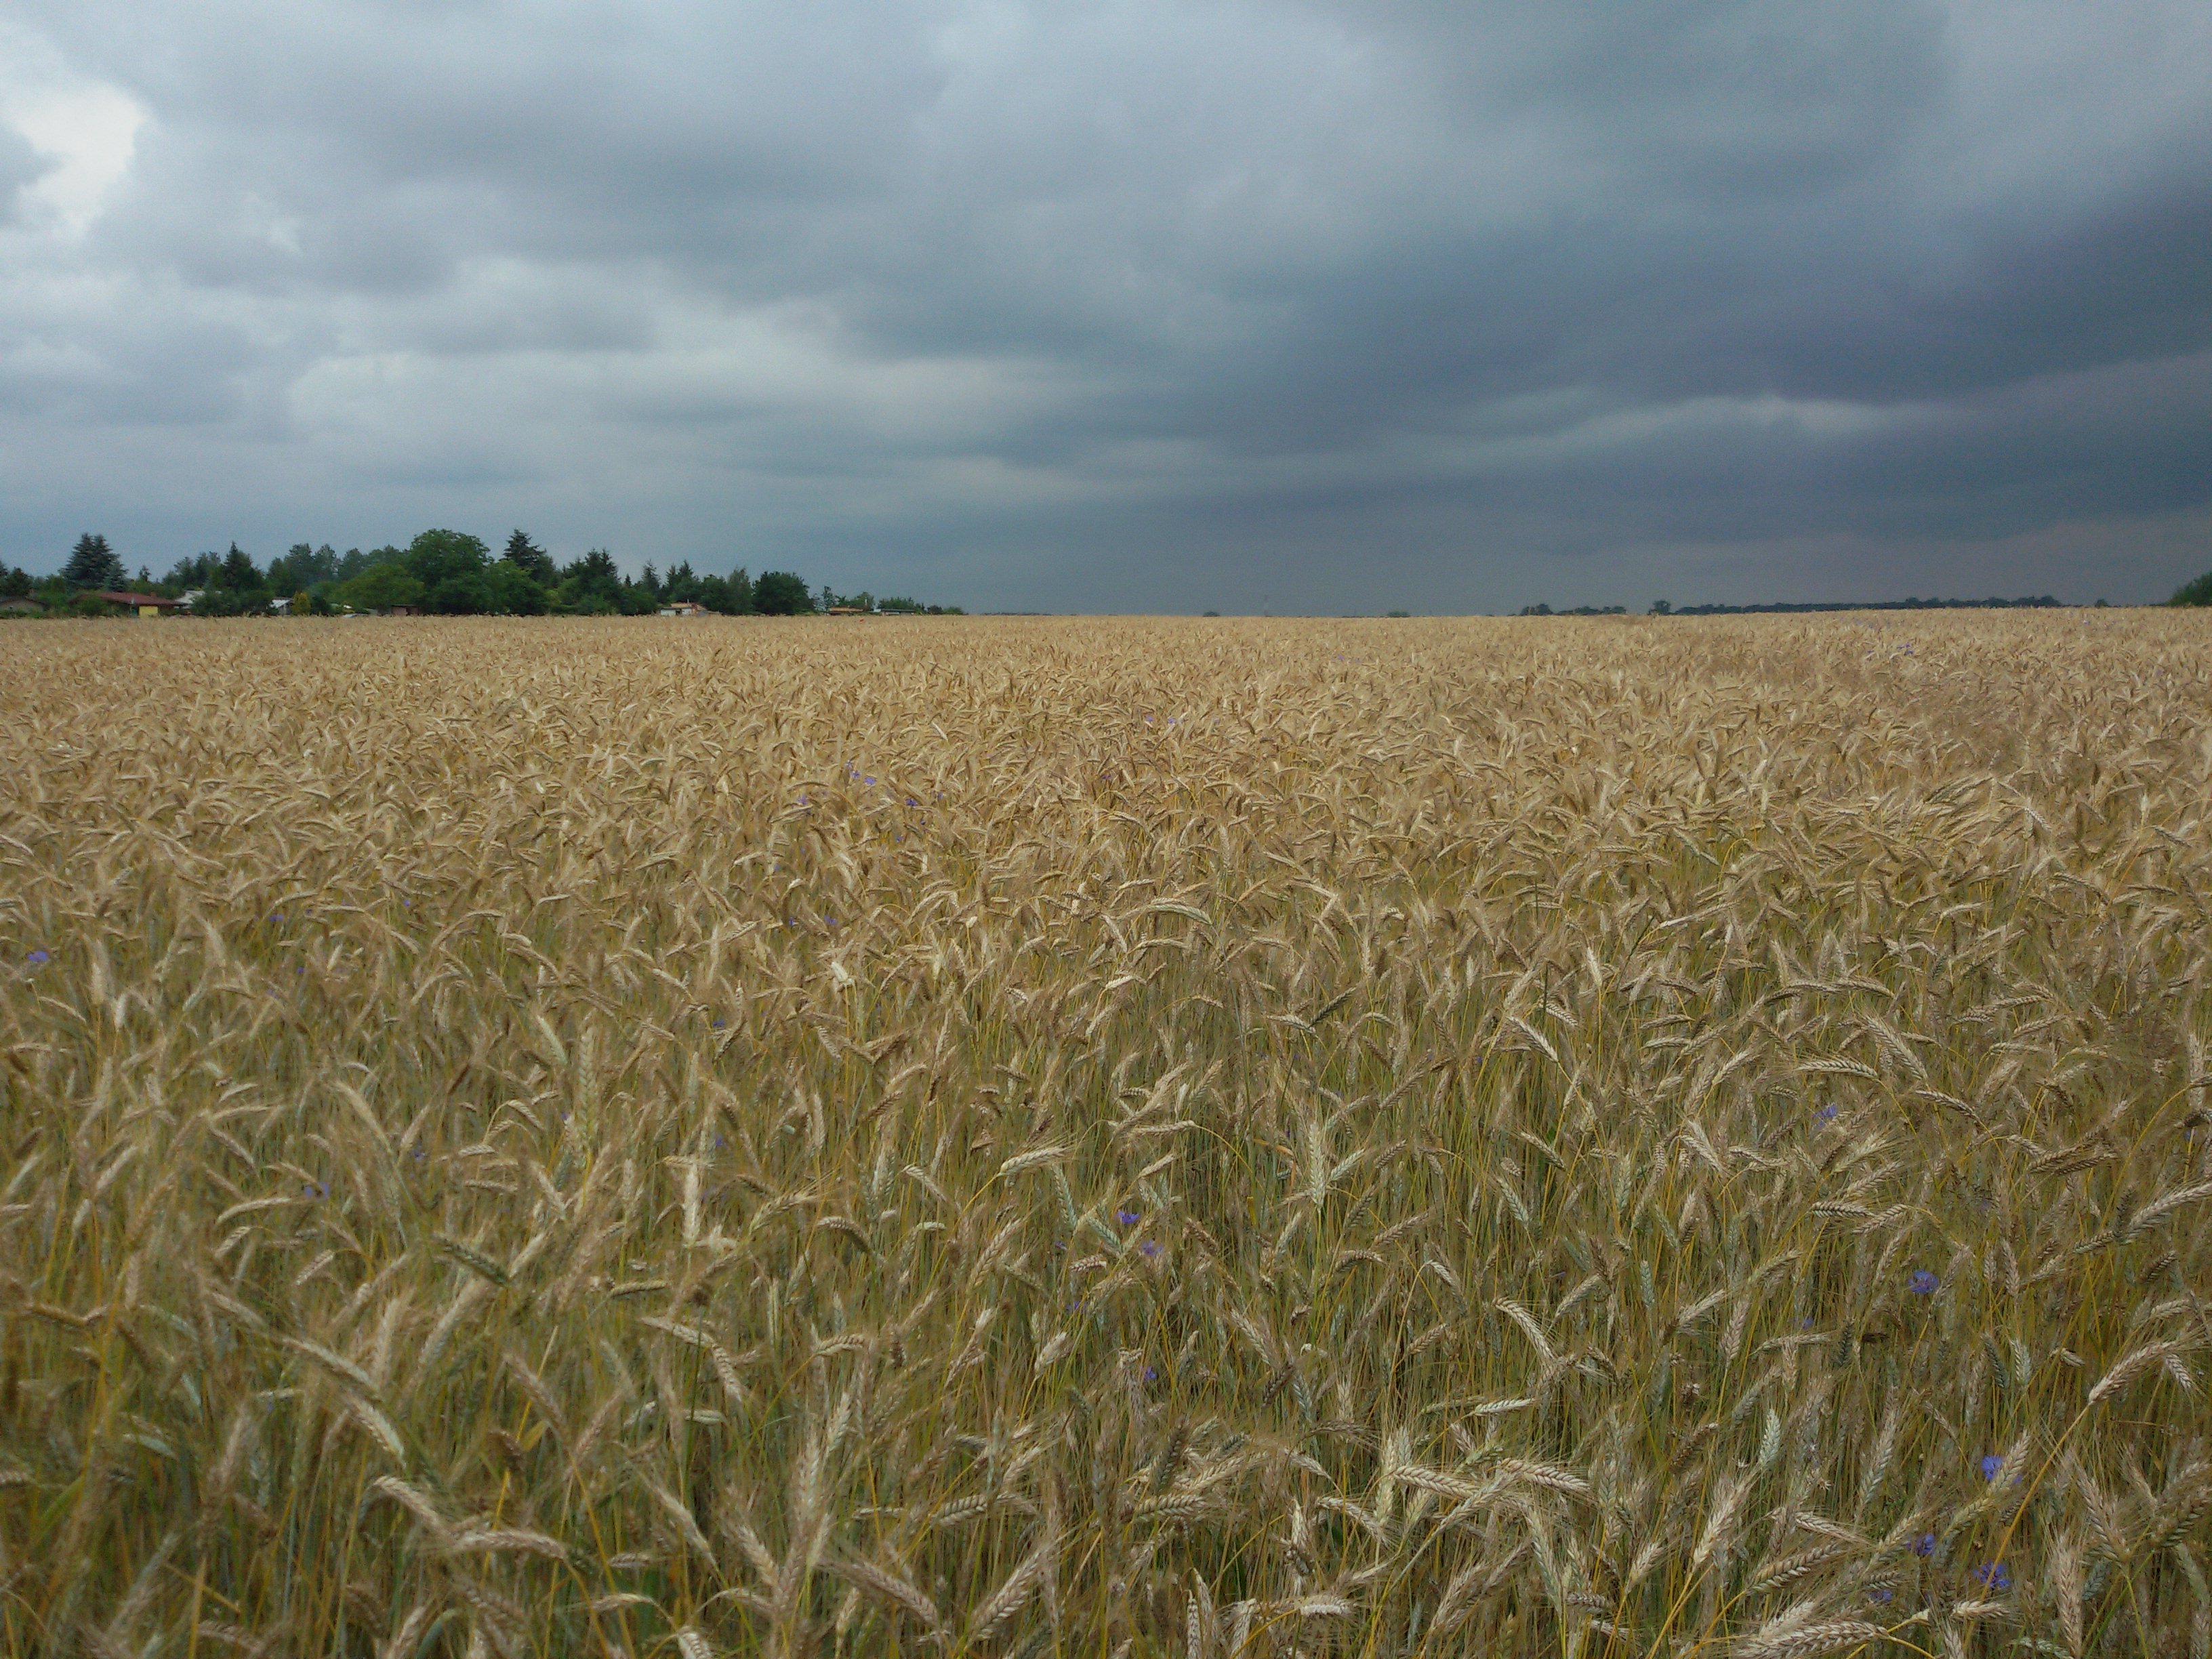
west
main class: Cropland
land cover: Triticale
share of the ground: > 75 %
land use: Agriculture (excluding fallow land and kitchen gardens)
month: July
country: PL
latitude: 52.3165
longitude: 16.9778
